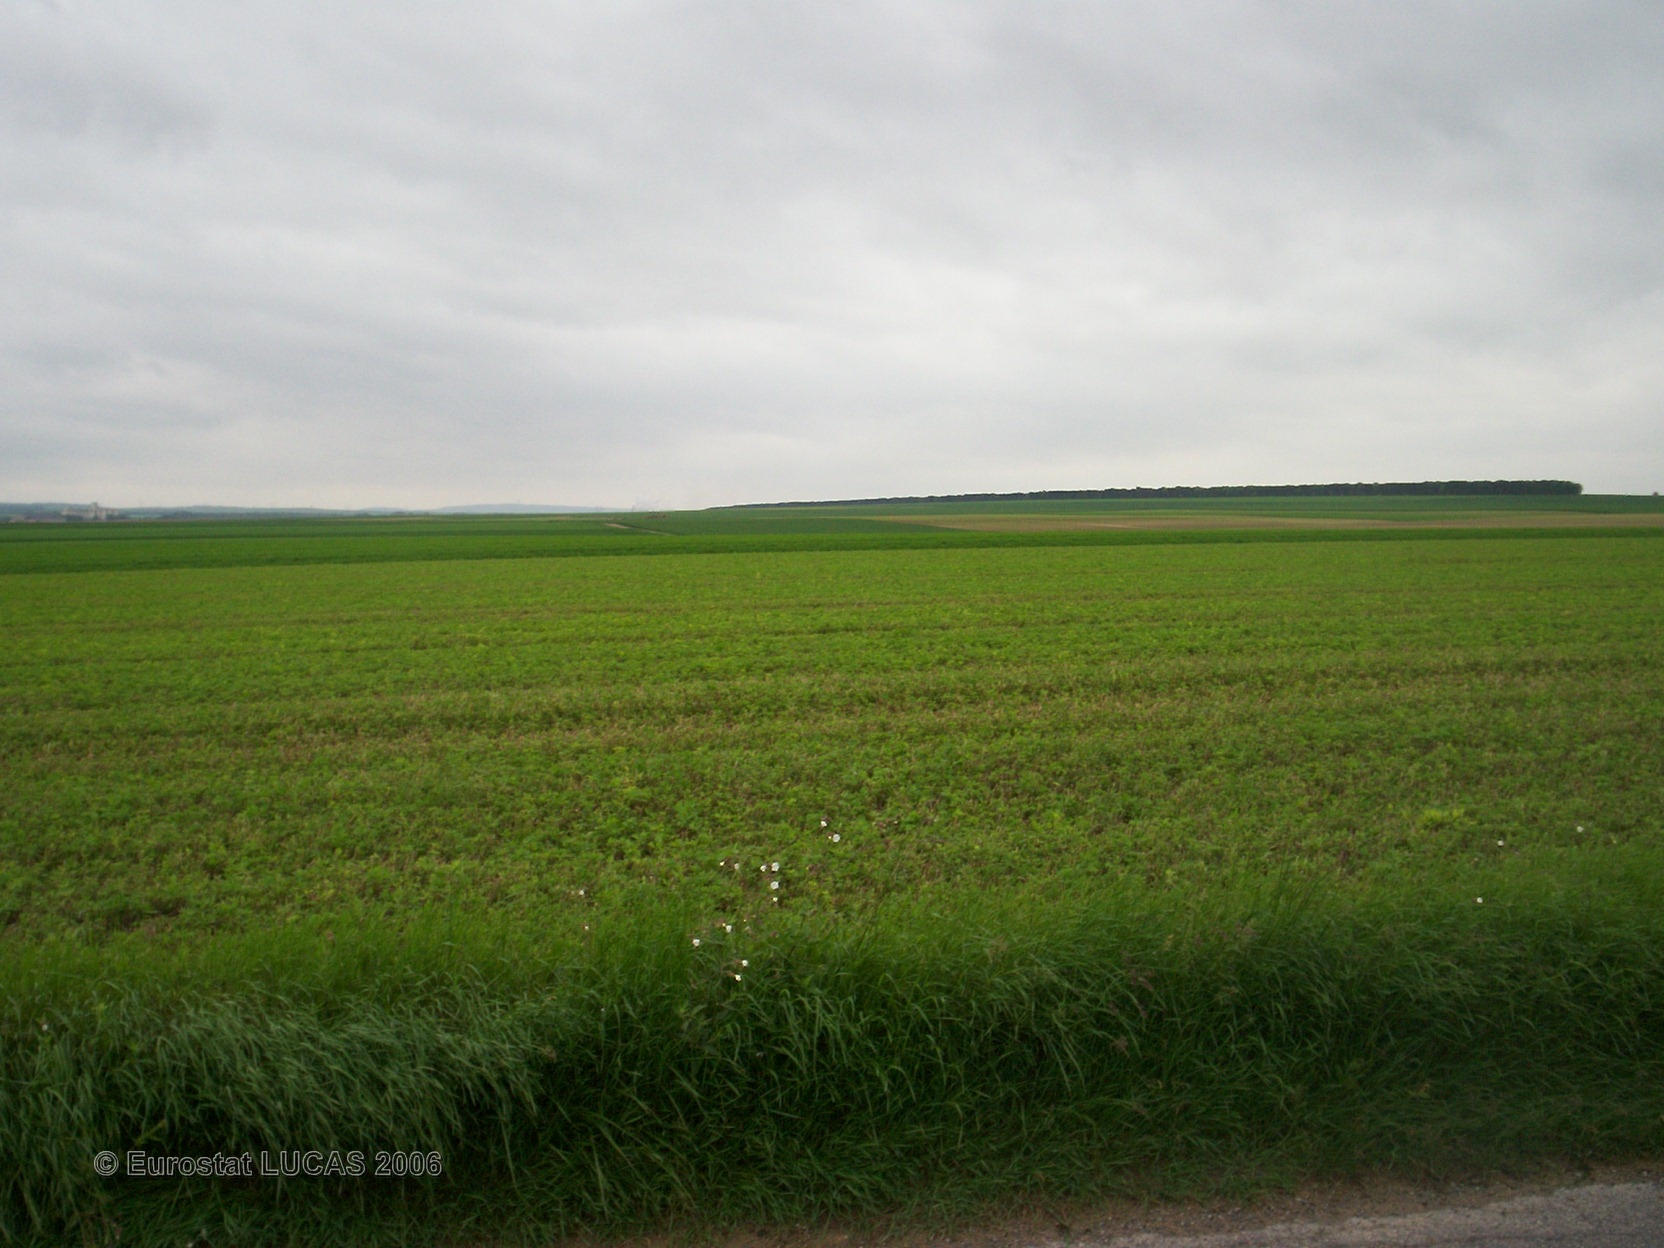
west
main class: Cropland
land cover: Lucerne
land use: Agriculture (excluding fallow land and kitchen gardens)
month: May
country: FR
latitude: 49.3074
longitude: 4.3983
